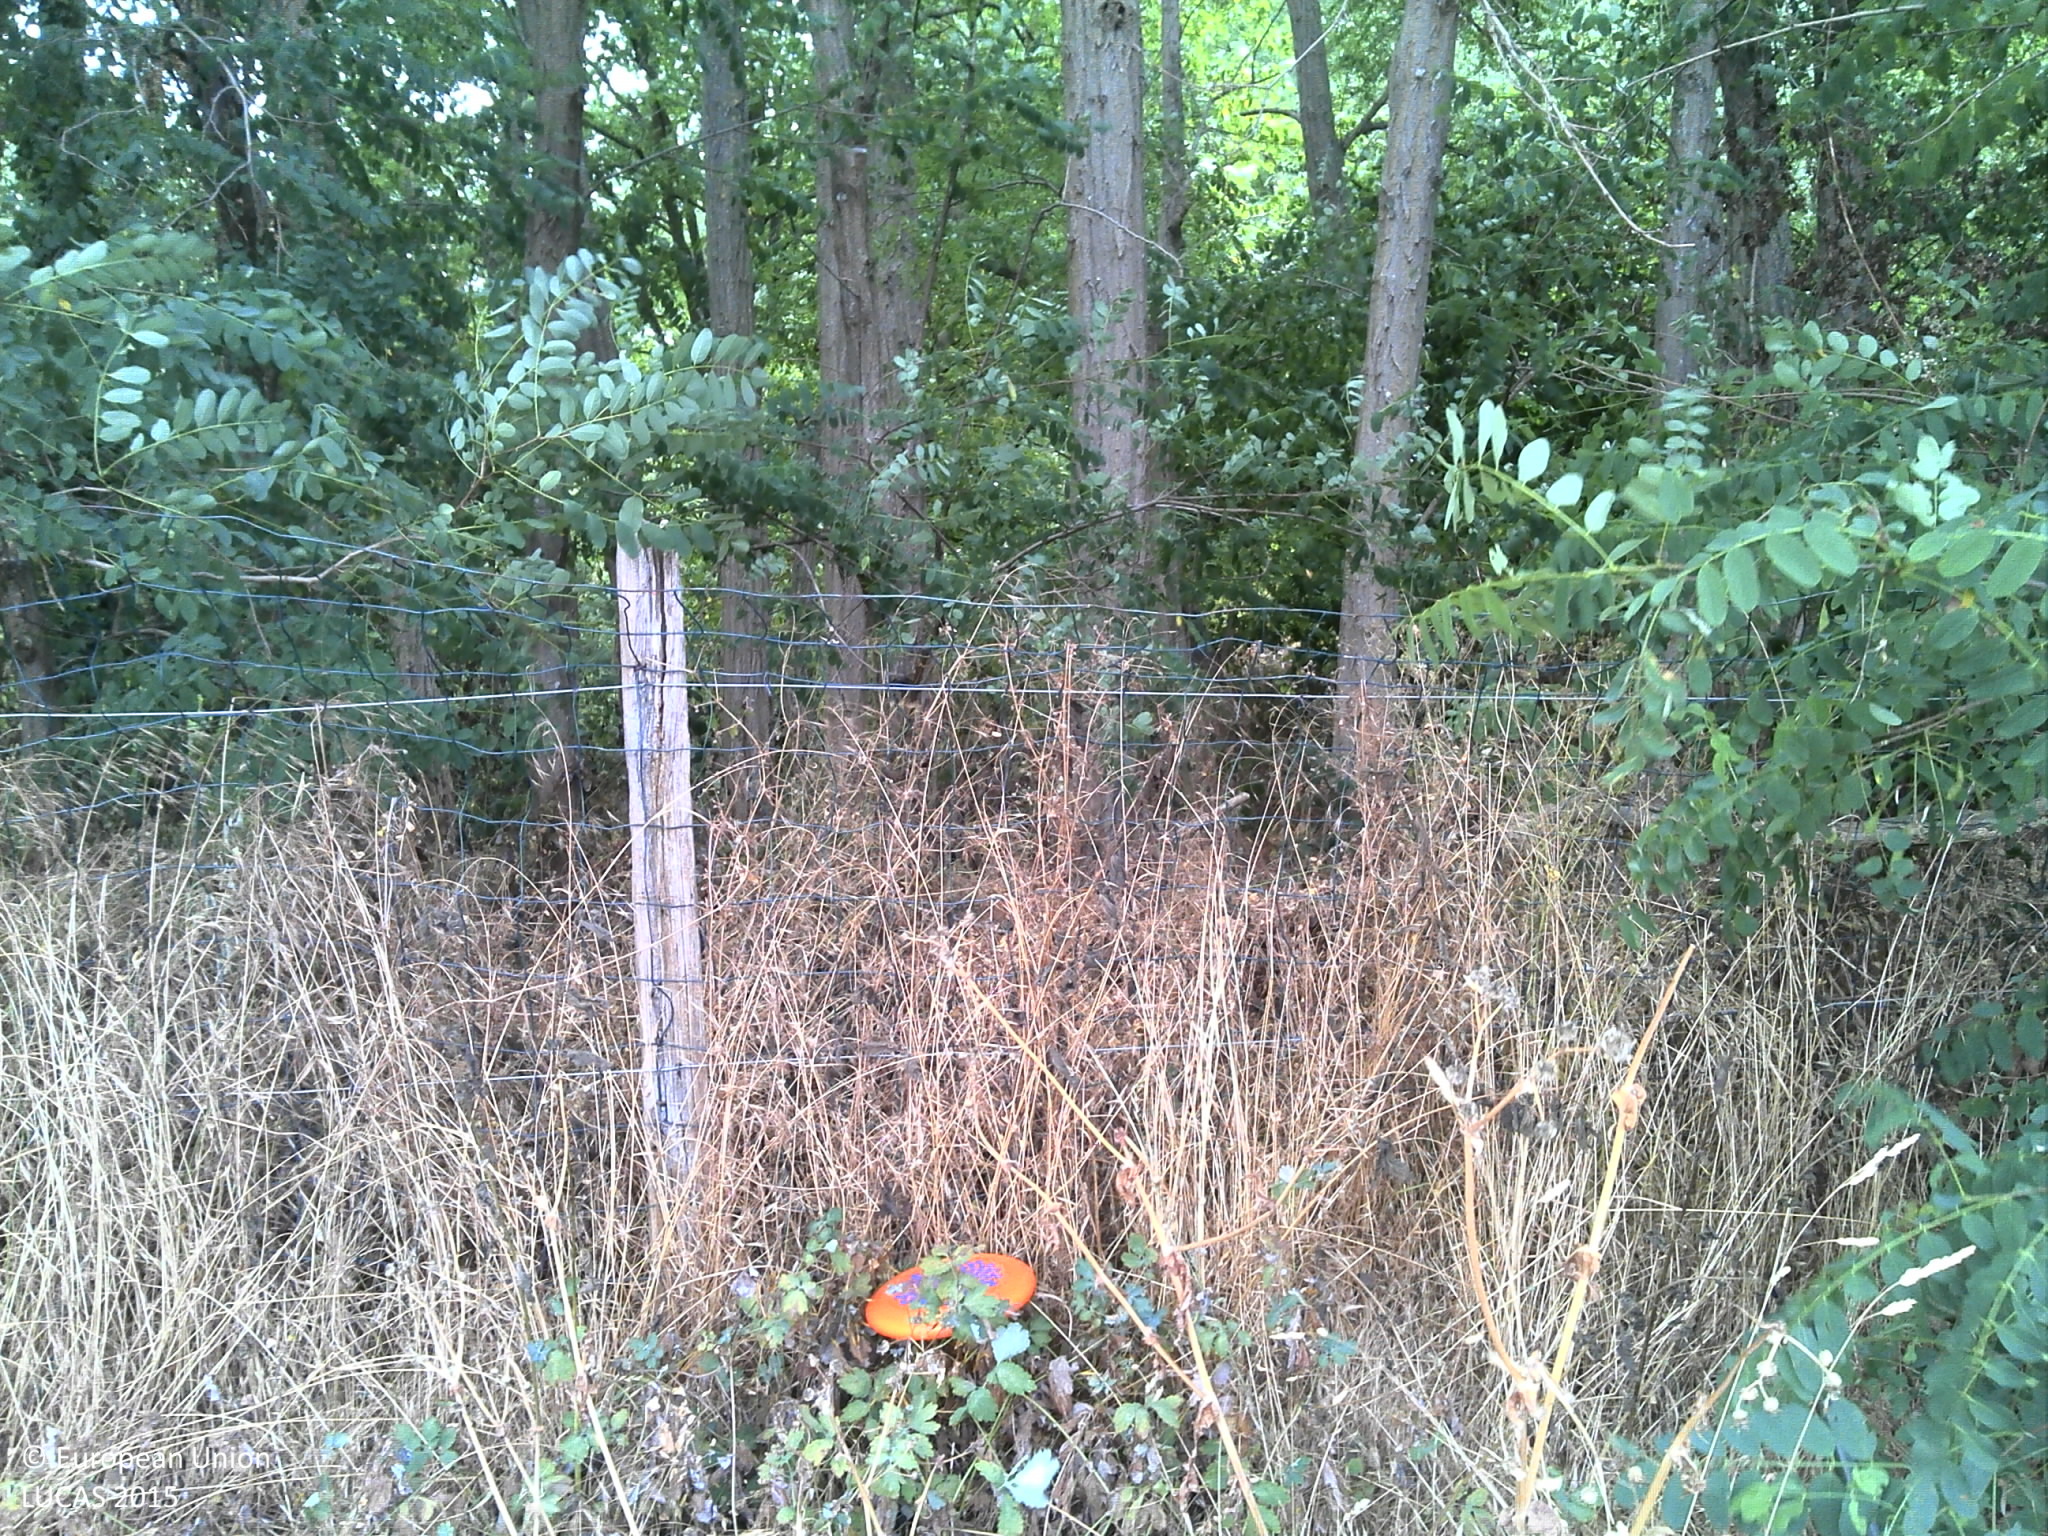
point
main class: Woodland
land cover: Broadleaved woodland
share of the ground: 25 - 50 %
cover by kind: broadleaved forest trees 80 %, herbaceous plants 20 %
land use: Agriculture (excluding fallow land and kitchen gardens)
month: July
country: FR
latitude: 48.5602
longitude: 2.4417
